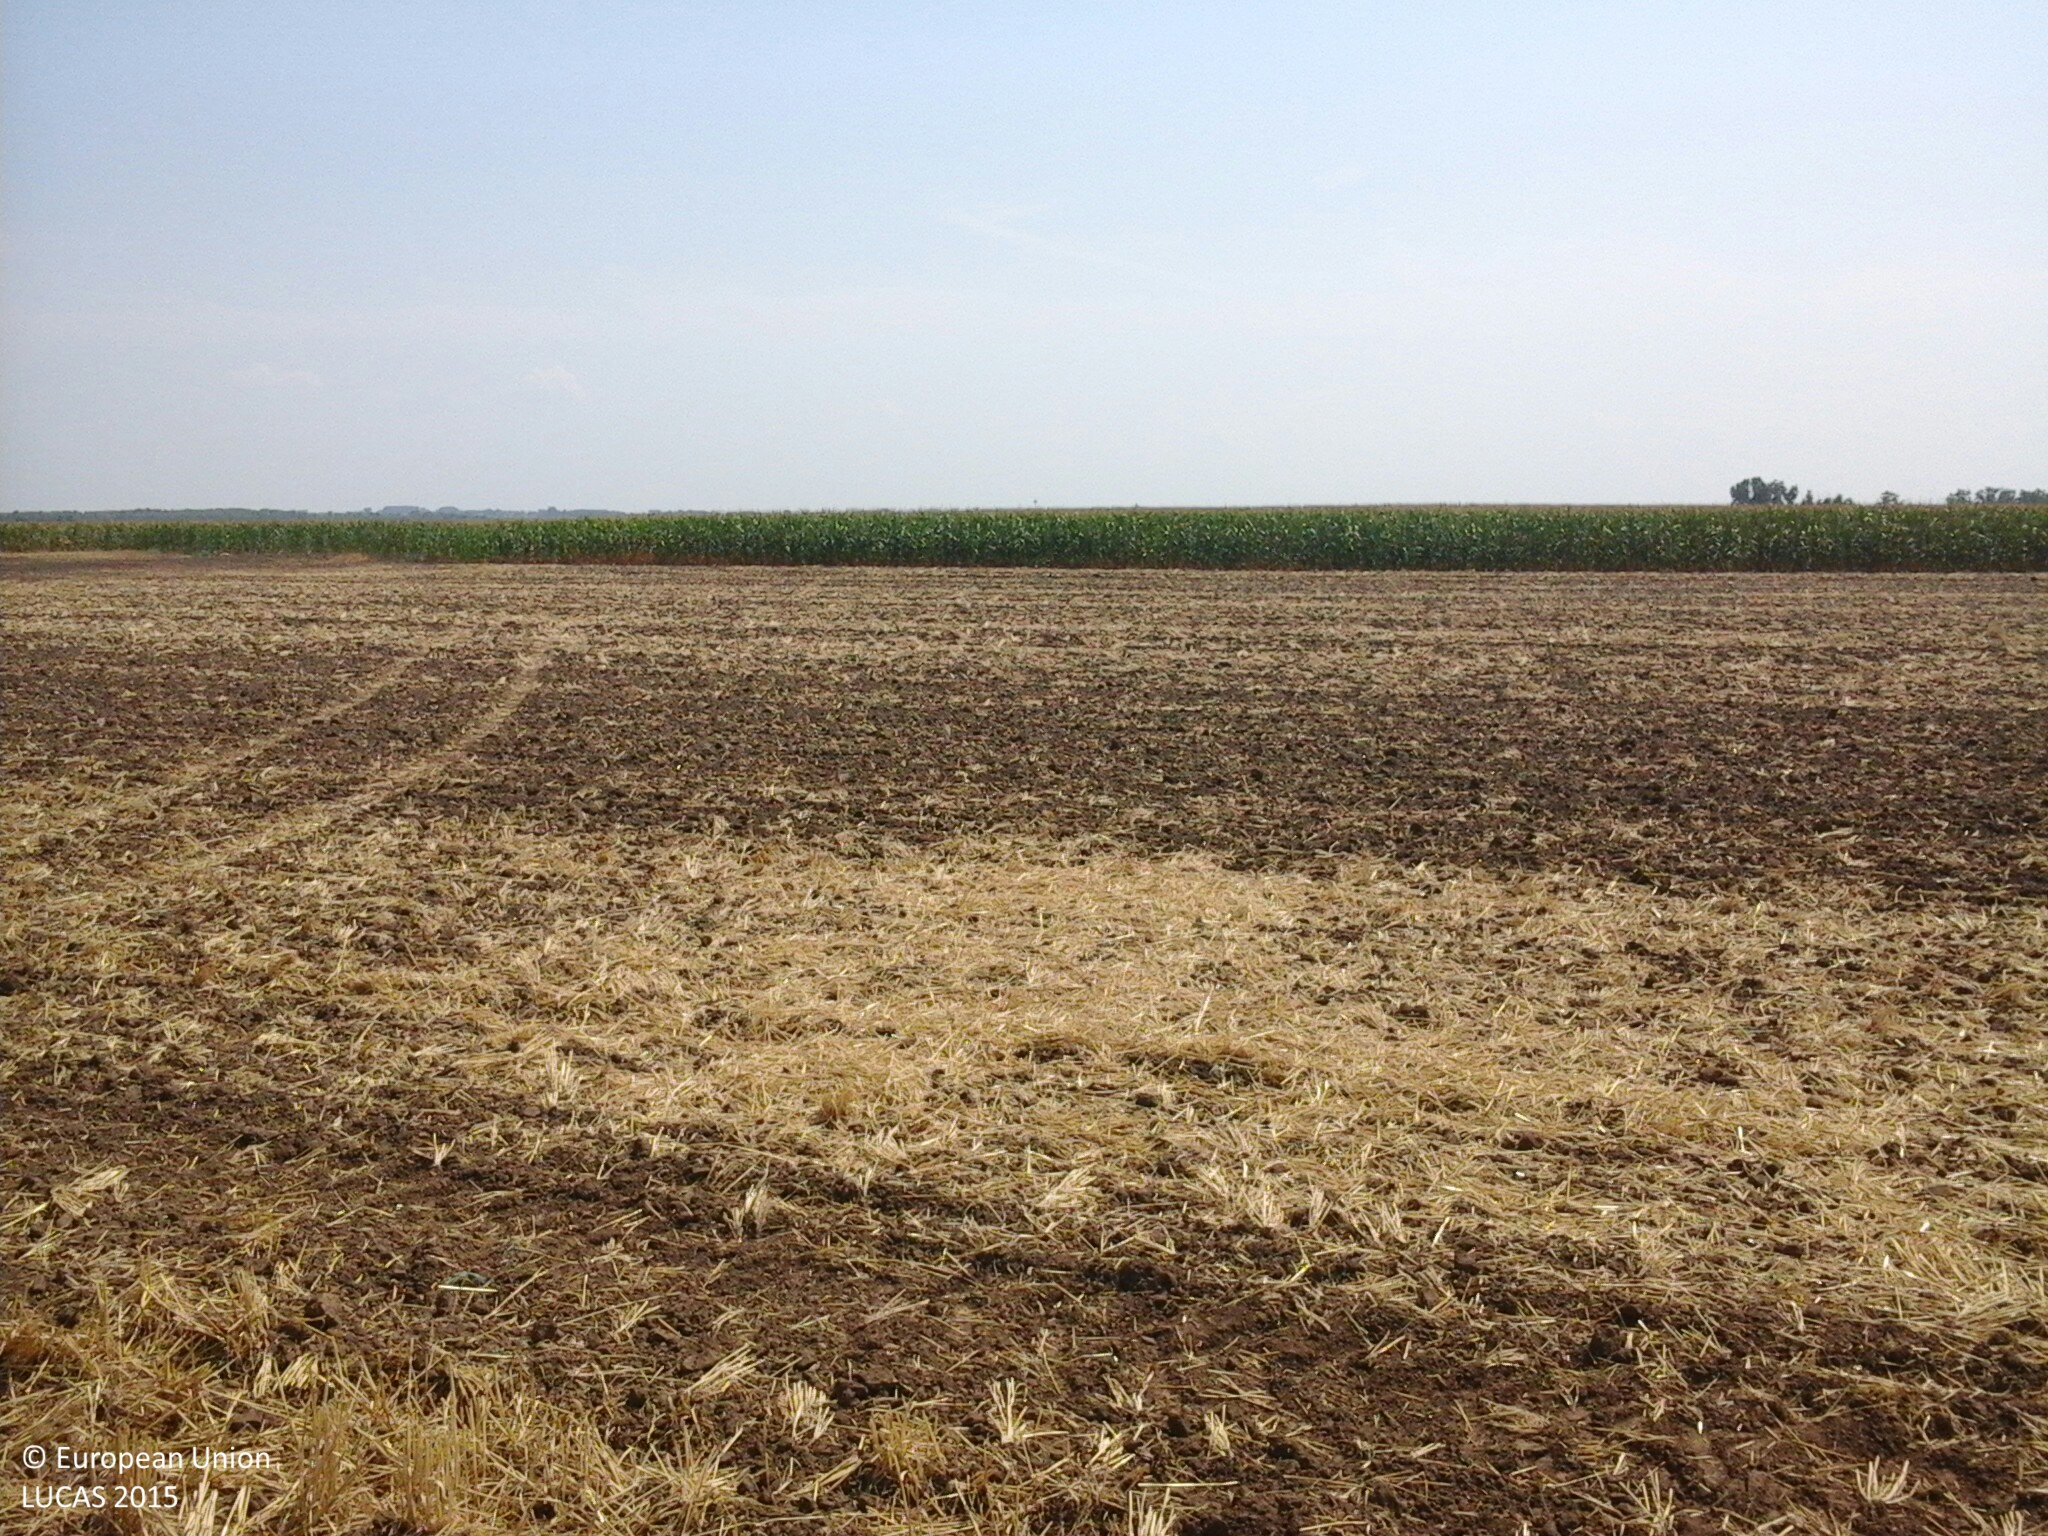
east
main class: Cropland
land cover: Common wheat
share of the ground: < 10 %
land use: Agriculture (excluding fallow land and kitchen gardens)
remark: Harvested field
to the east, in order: Common wheat; Maize; Grass margins; Paved roads, cycling and walking lanes; Grass margins; Maize
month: August
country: HU
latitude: 46.9670
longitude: 18.3305
